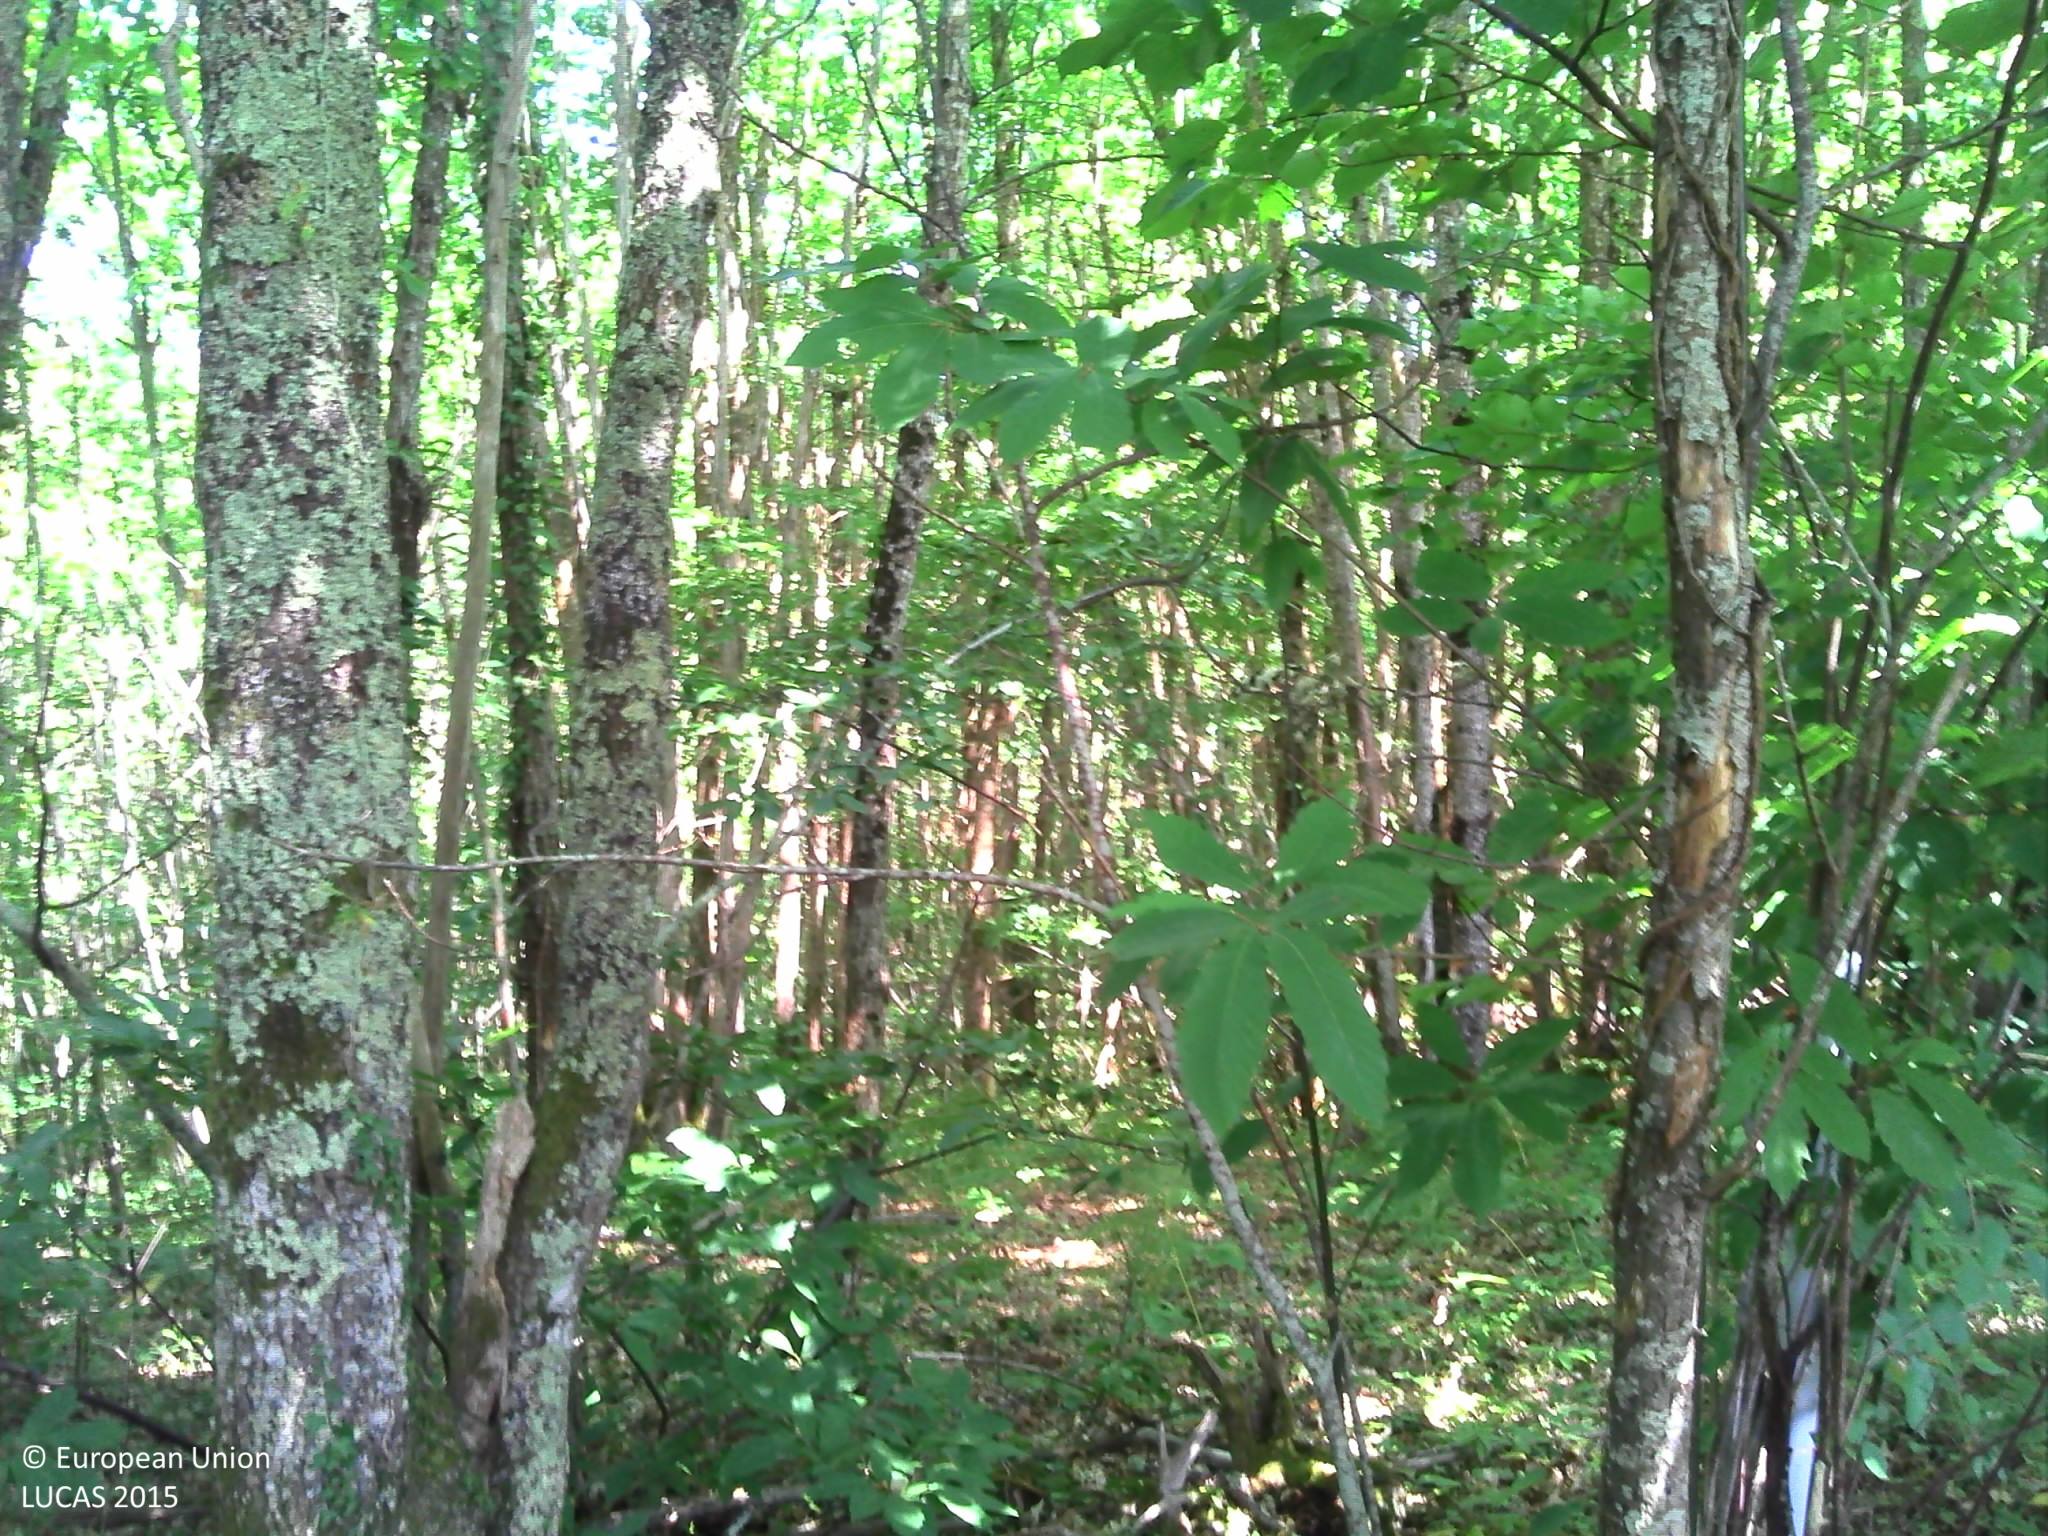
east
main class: Woodland
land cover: Broadleaved woodland
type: thermophilous deciduous forest
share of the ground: > 75 %
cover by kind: broadleaved forest trees 80 %, herbaceous plants 10 %, coniferous forest trees 5 %, shrubs 5 %
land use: Forestry
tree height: > 5 m
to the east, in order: Broadleaved woodland; Shruby margins; Grassland without tree/shrub cover; Ditches and canals; Grassland without tree/shrub cover
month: July
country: FR
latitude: 45.0775
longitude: 0.5256
